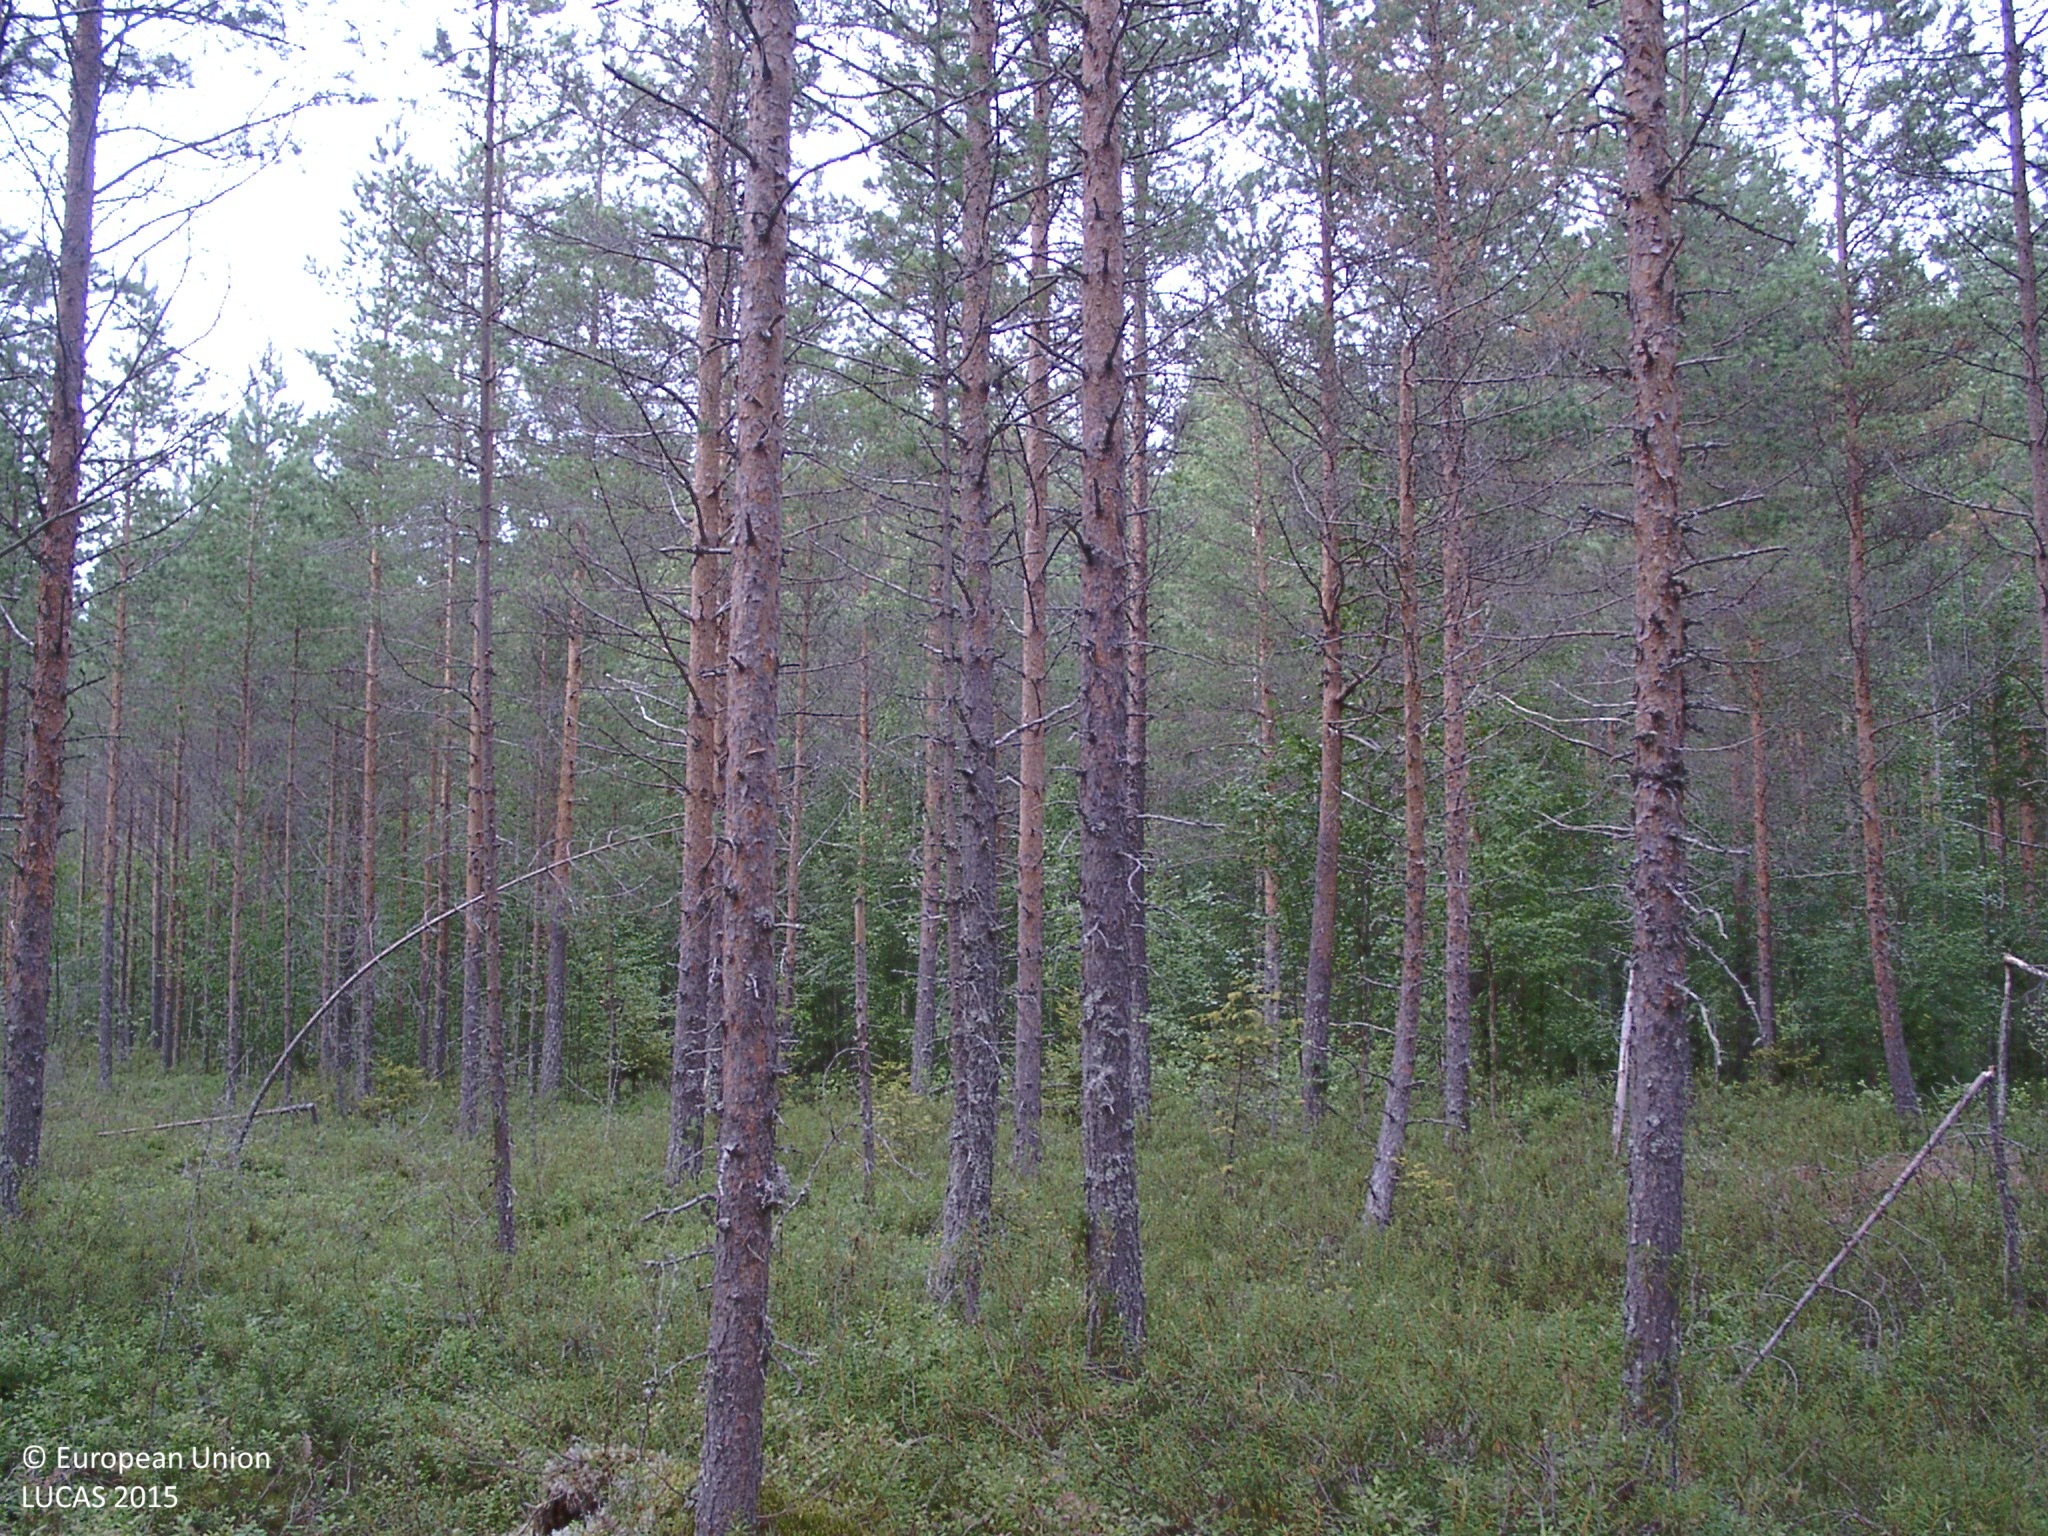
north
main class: Woodland
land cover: Pine dominated coniferous woodland
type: mire and swamp forests
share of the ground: 50 - 75 %
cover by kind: coniferous forest trees 55 %, shrubs 30 %, lichens and mosses 10 %, broadleaved forest trees 5 %
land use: Forestry
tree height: > 5 m
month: August
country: FI
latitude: 62.9846
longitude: 24.7521
